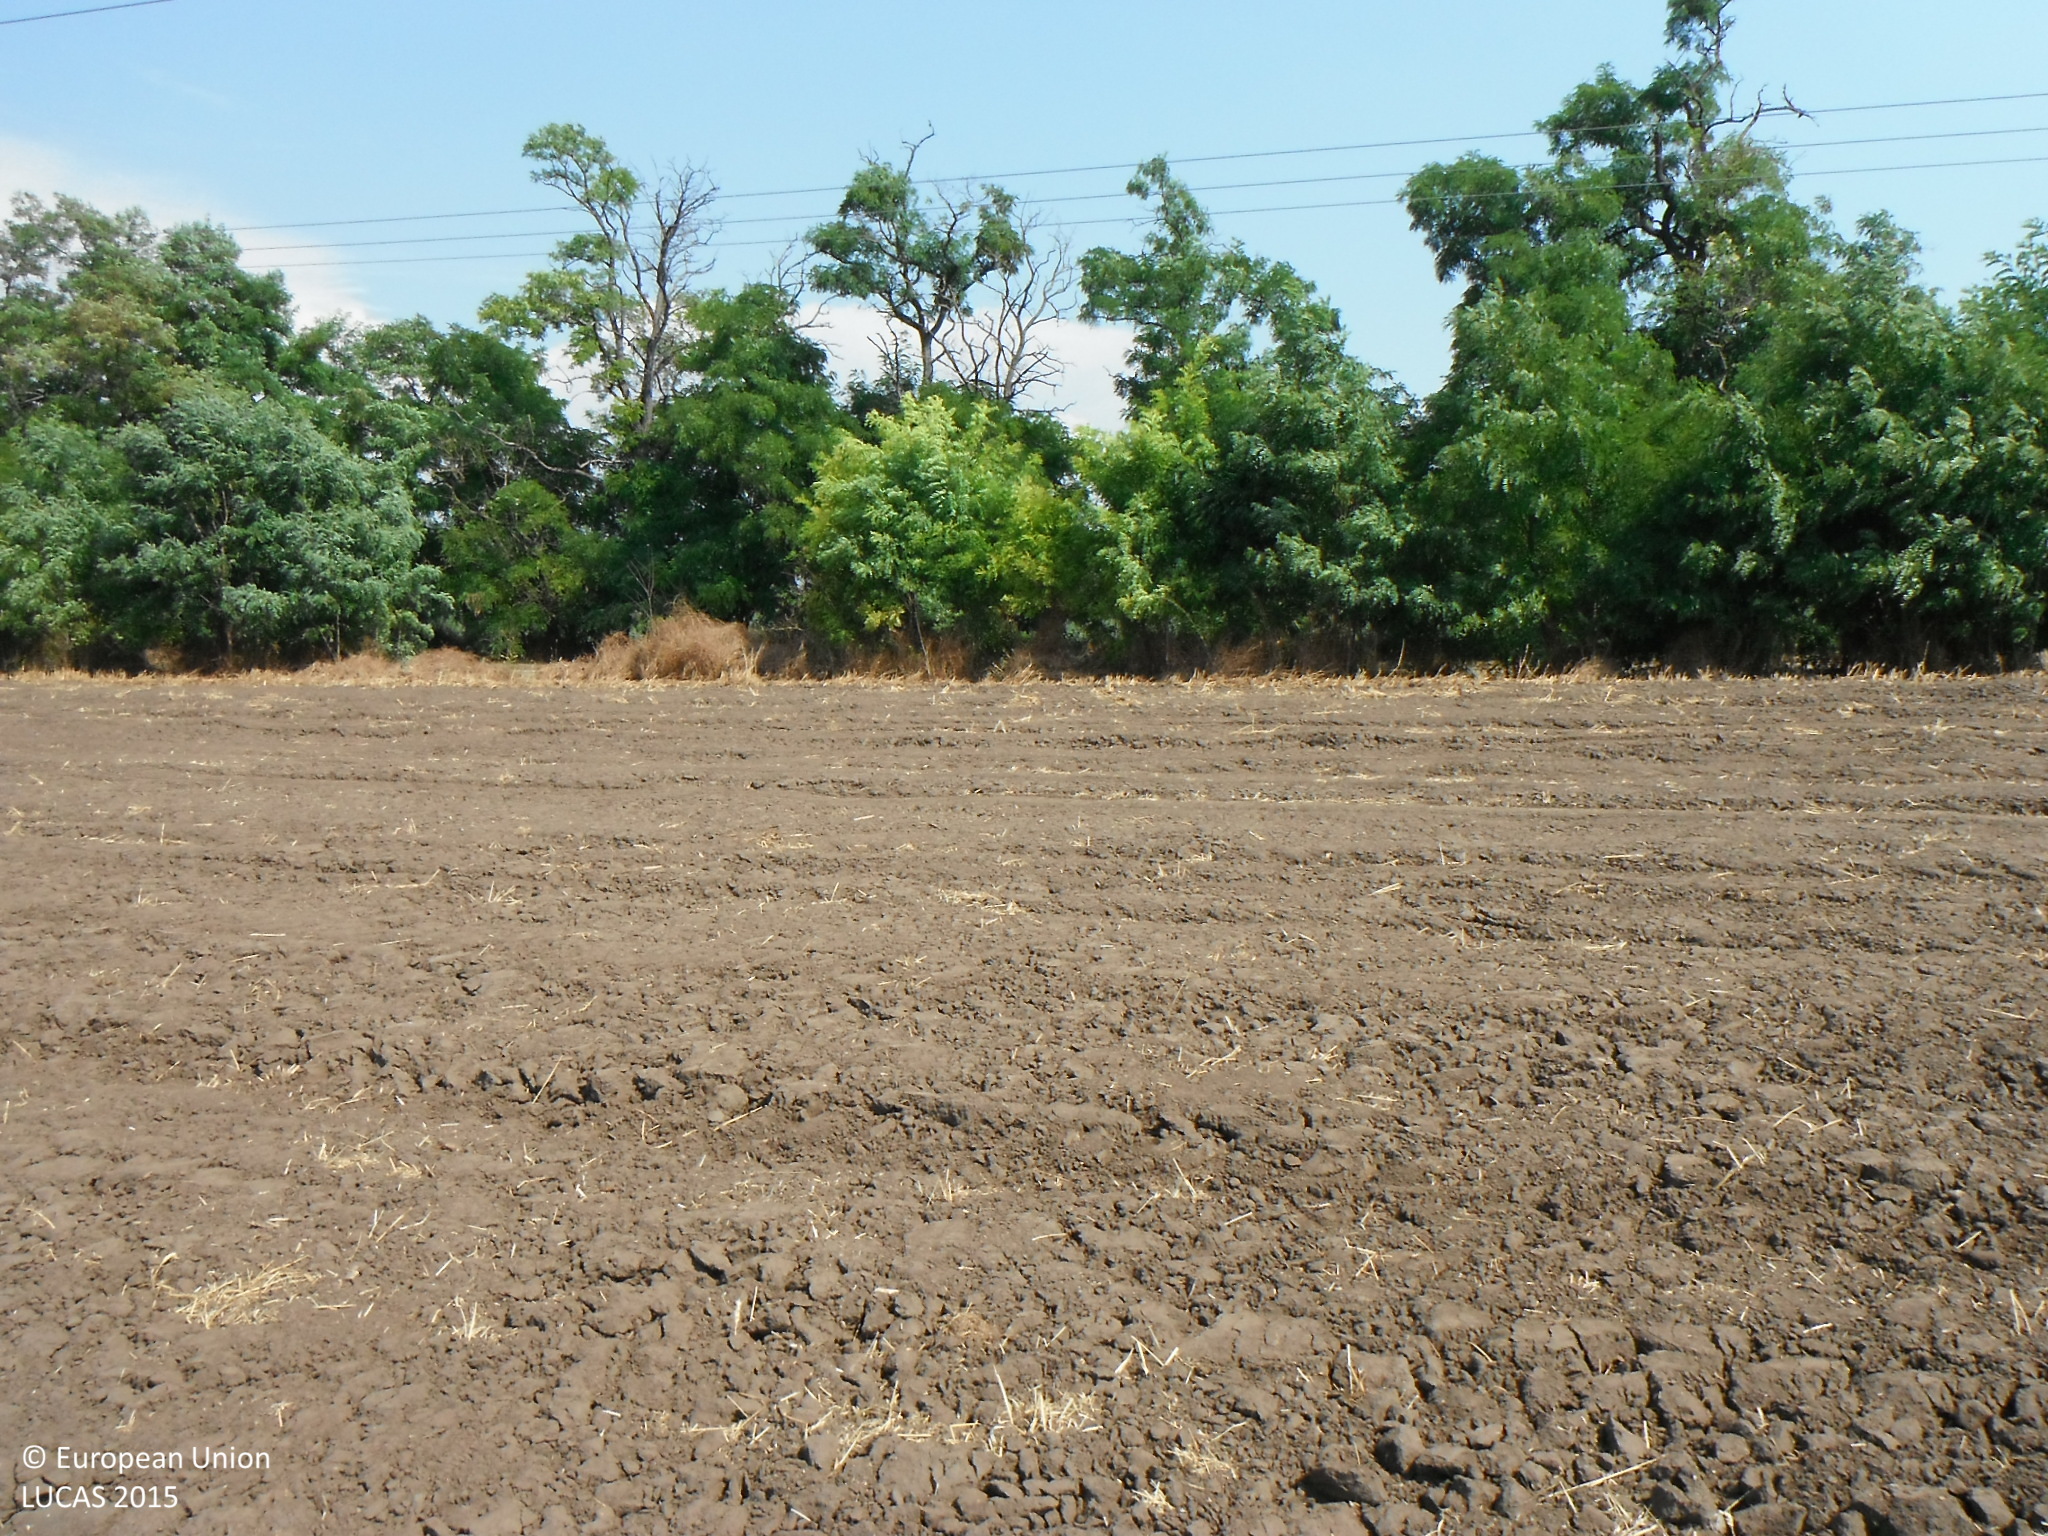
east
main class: Cropland
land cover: Common wheat
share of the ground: < 10 %
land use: Agriculture (excluding fallow land and kitchen gardens)
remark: Harvested field
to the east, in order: Common wheat; Electric lines; Common wheat; Abandoned hedges; Shruby margins; Paved roads, cycling and walking lanes; Broadleaved woodland; Electric lines; Broadleaved woodland; Other fibre and oleaginous crops
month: August
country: SK
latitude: 48.0079
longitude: 18.2038
